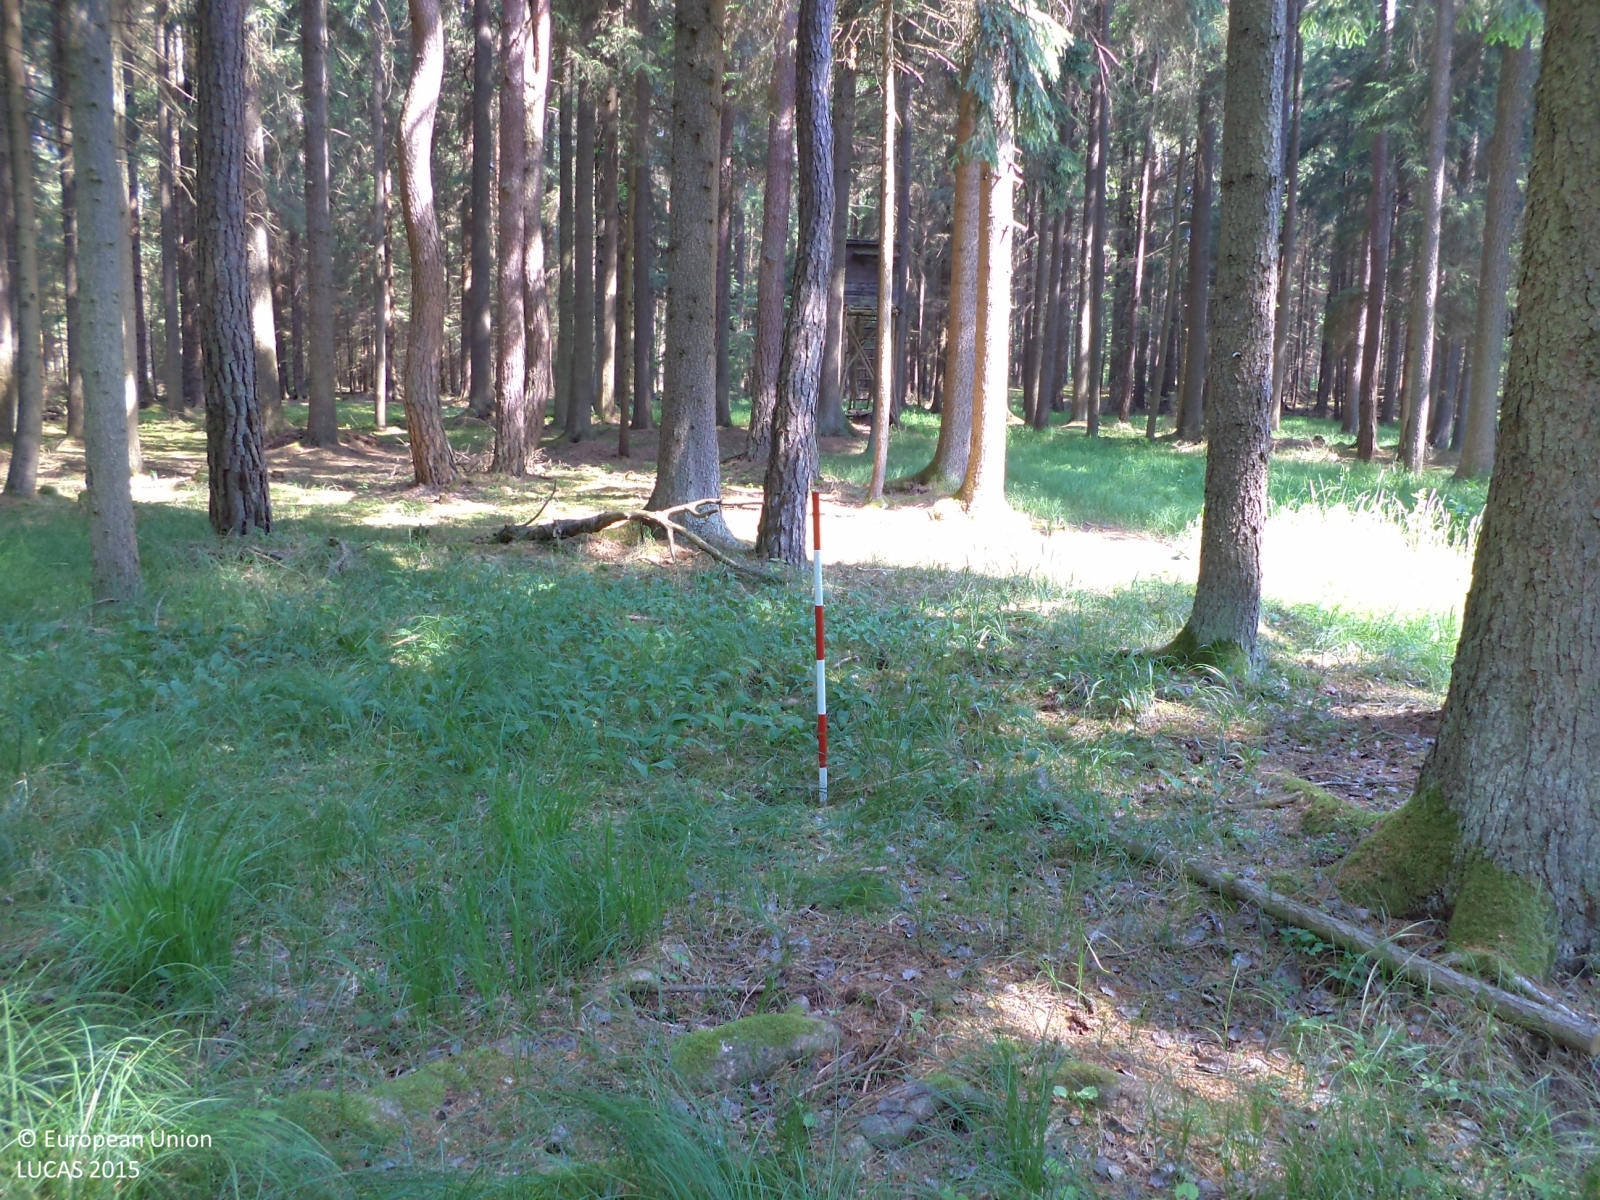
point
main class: Woodland
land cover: Spruce dominated coniferous woodland
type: hemiboreal forest and nemoral coniferous forest and mixed broadleaved-coniferous forest
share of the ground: > 75 %
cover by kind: coniferous forest trees 80 %, herbaceous plants 20 %
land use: Forestry
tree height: > 5 m
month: June
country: CZ
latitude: 49.3421
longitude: 14.4194
